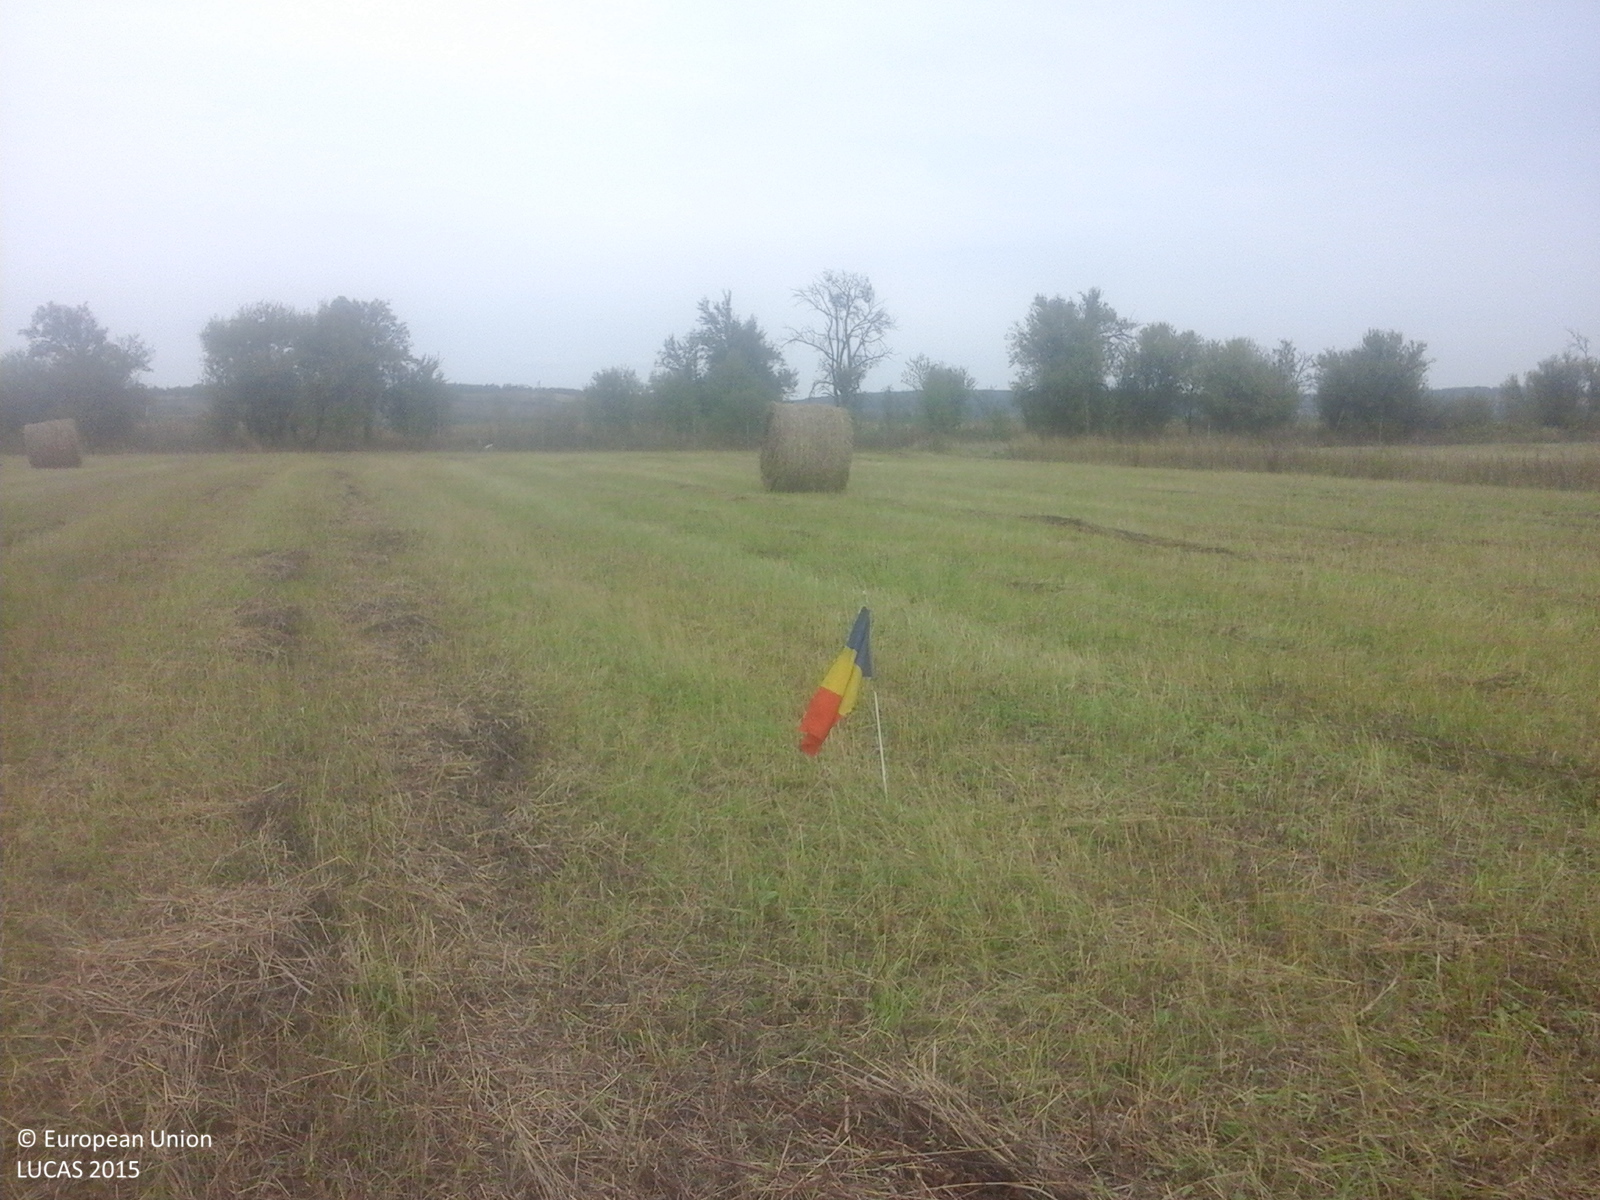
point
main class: Grassland
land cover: Grassland without tree/shrub cover
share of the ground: > 75 %
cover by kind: herbaceous plants 100 %
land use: Agriculture (excluding fallow land and kitchen gardens)
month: September
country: RO
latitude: 45.8398
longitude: 22.1323
